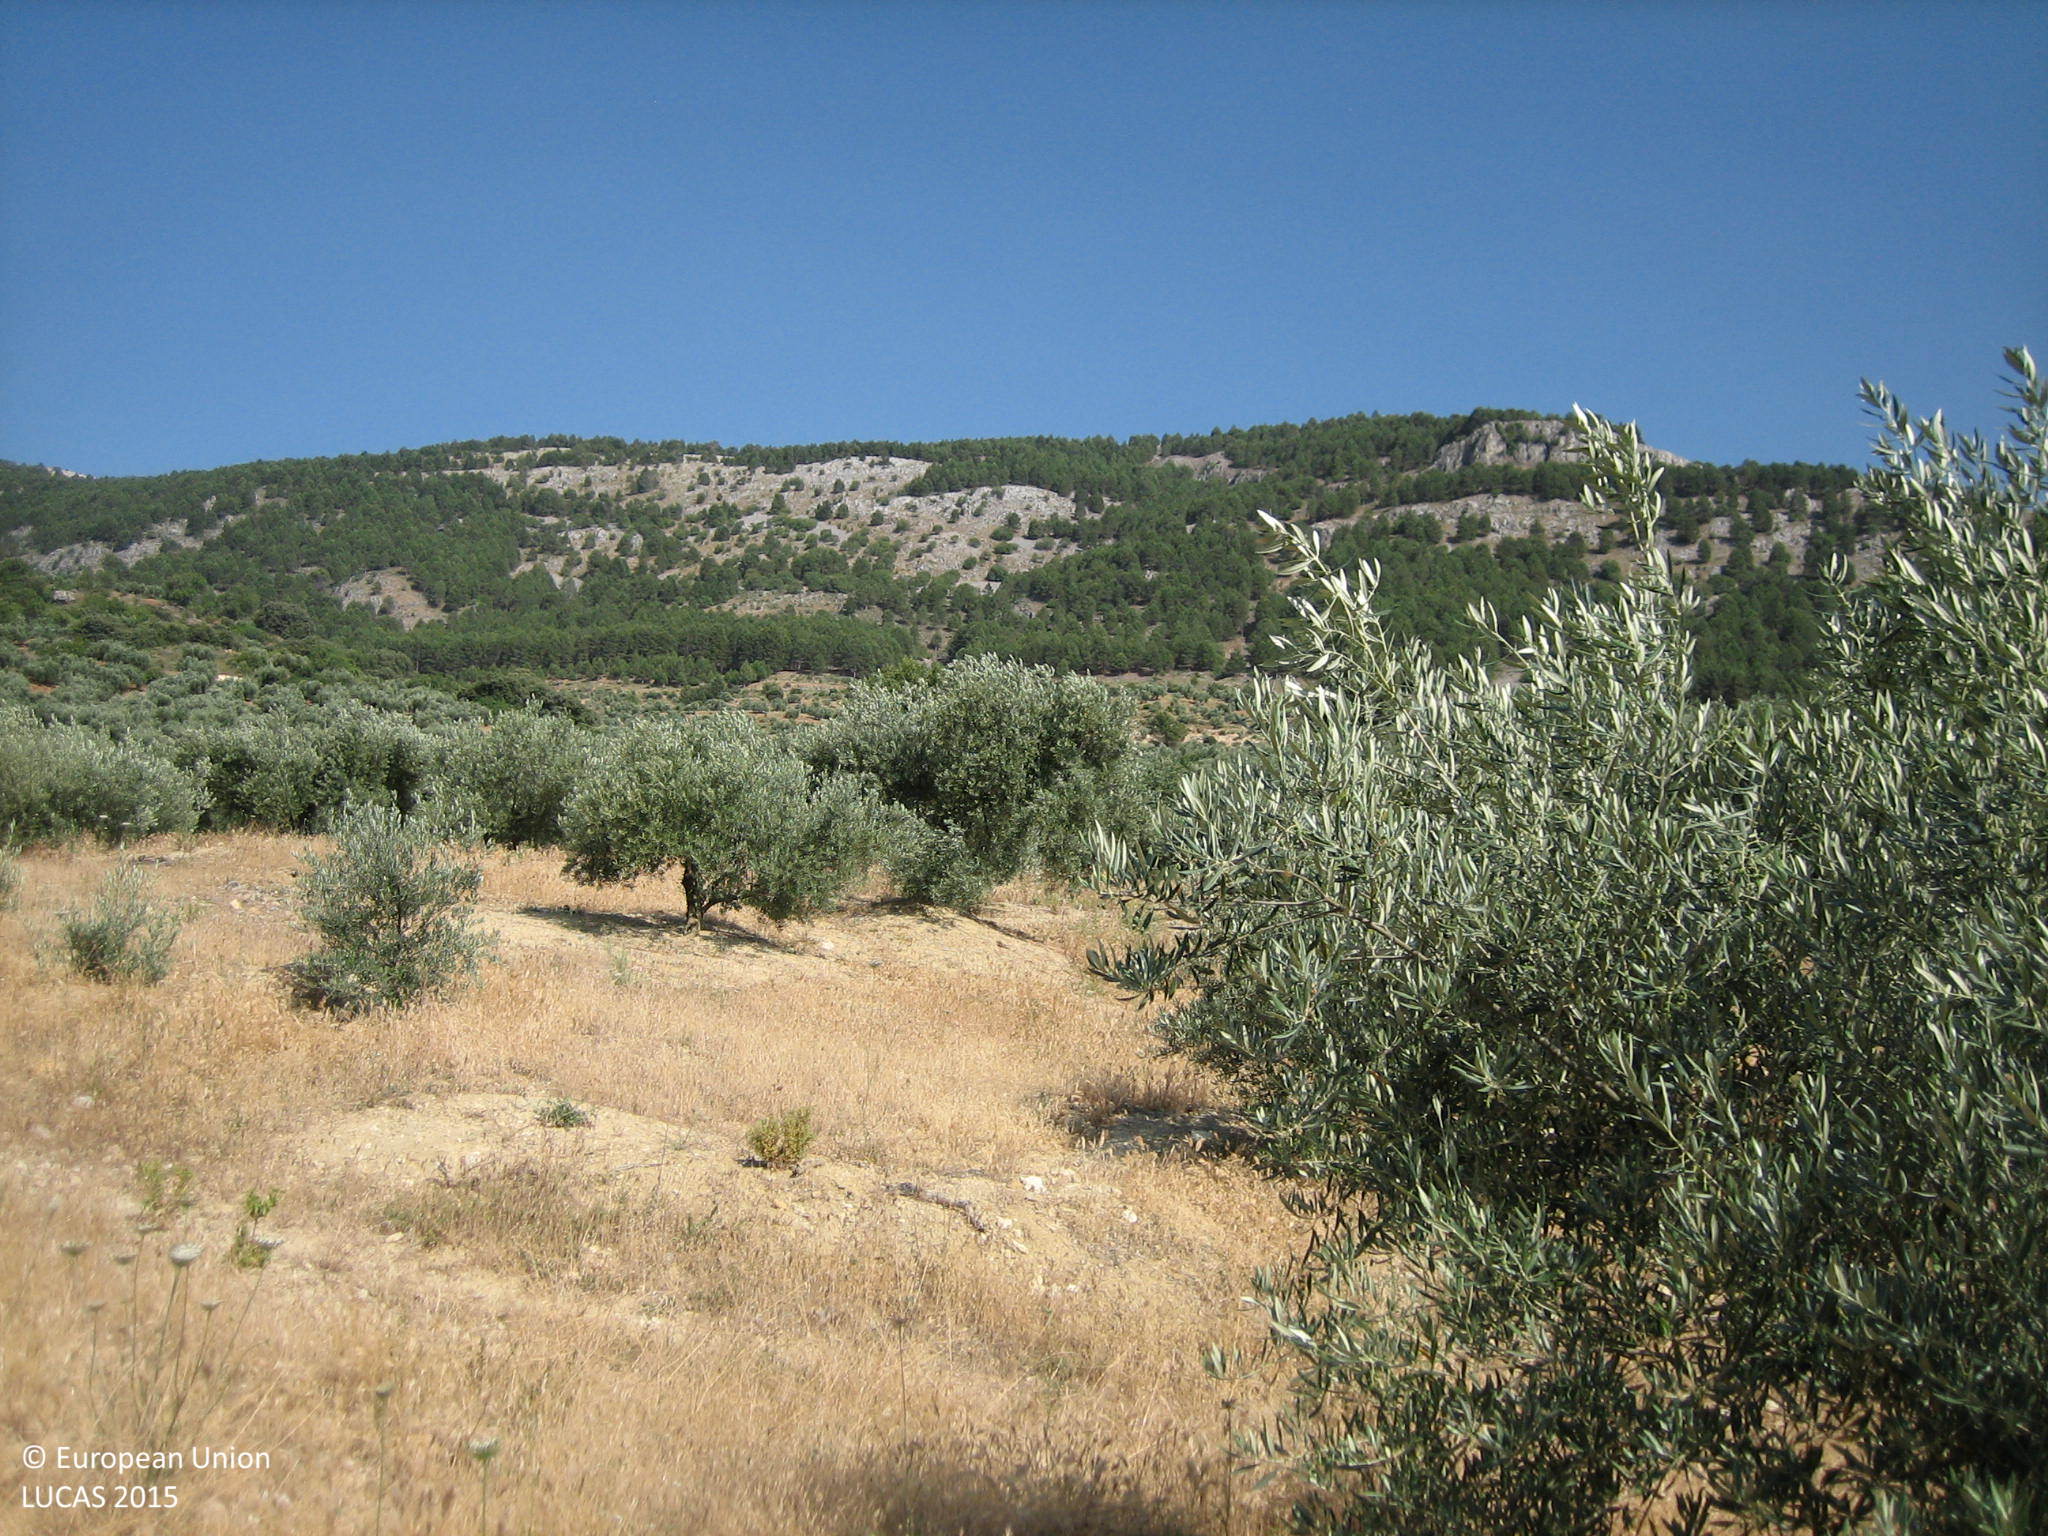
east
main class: Cropland
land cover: Olive groves
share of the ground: 10 - 25 %
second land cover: Spontaneously vegetated surfaces
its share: 10 - 25 %
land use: Agriculture (excluding fallow land and kitchen gardens)
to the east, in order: Olive groves; Spontaneously vegetated surfaces; Tracks; Olive groves; Rivers and streams; Olive groves
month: June
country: ES
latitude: 37.5986
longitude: -3.8050
